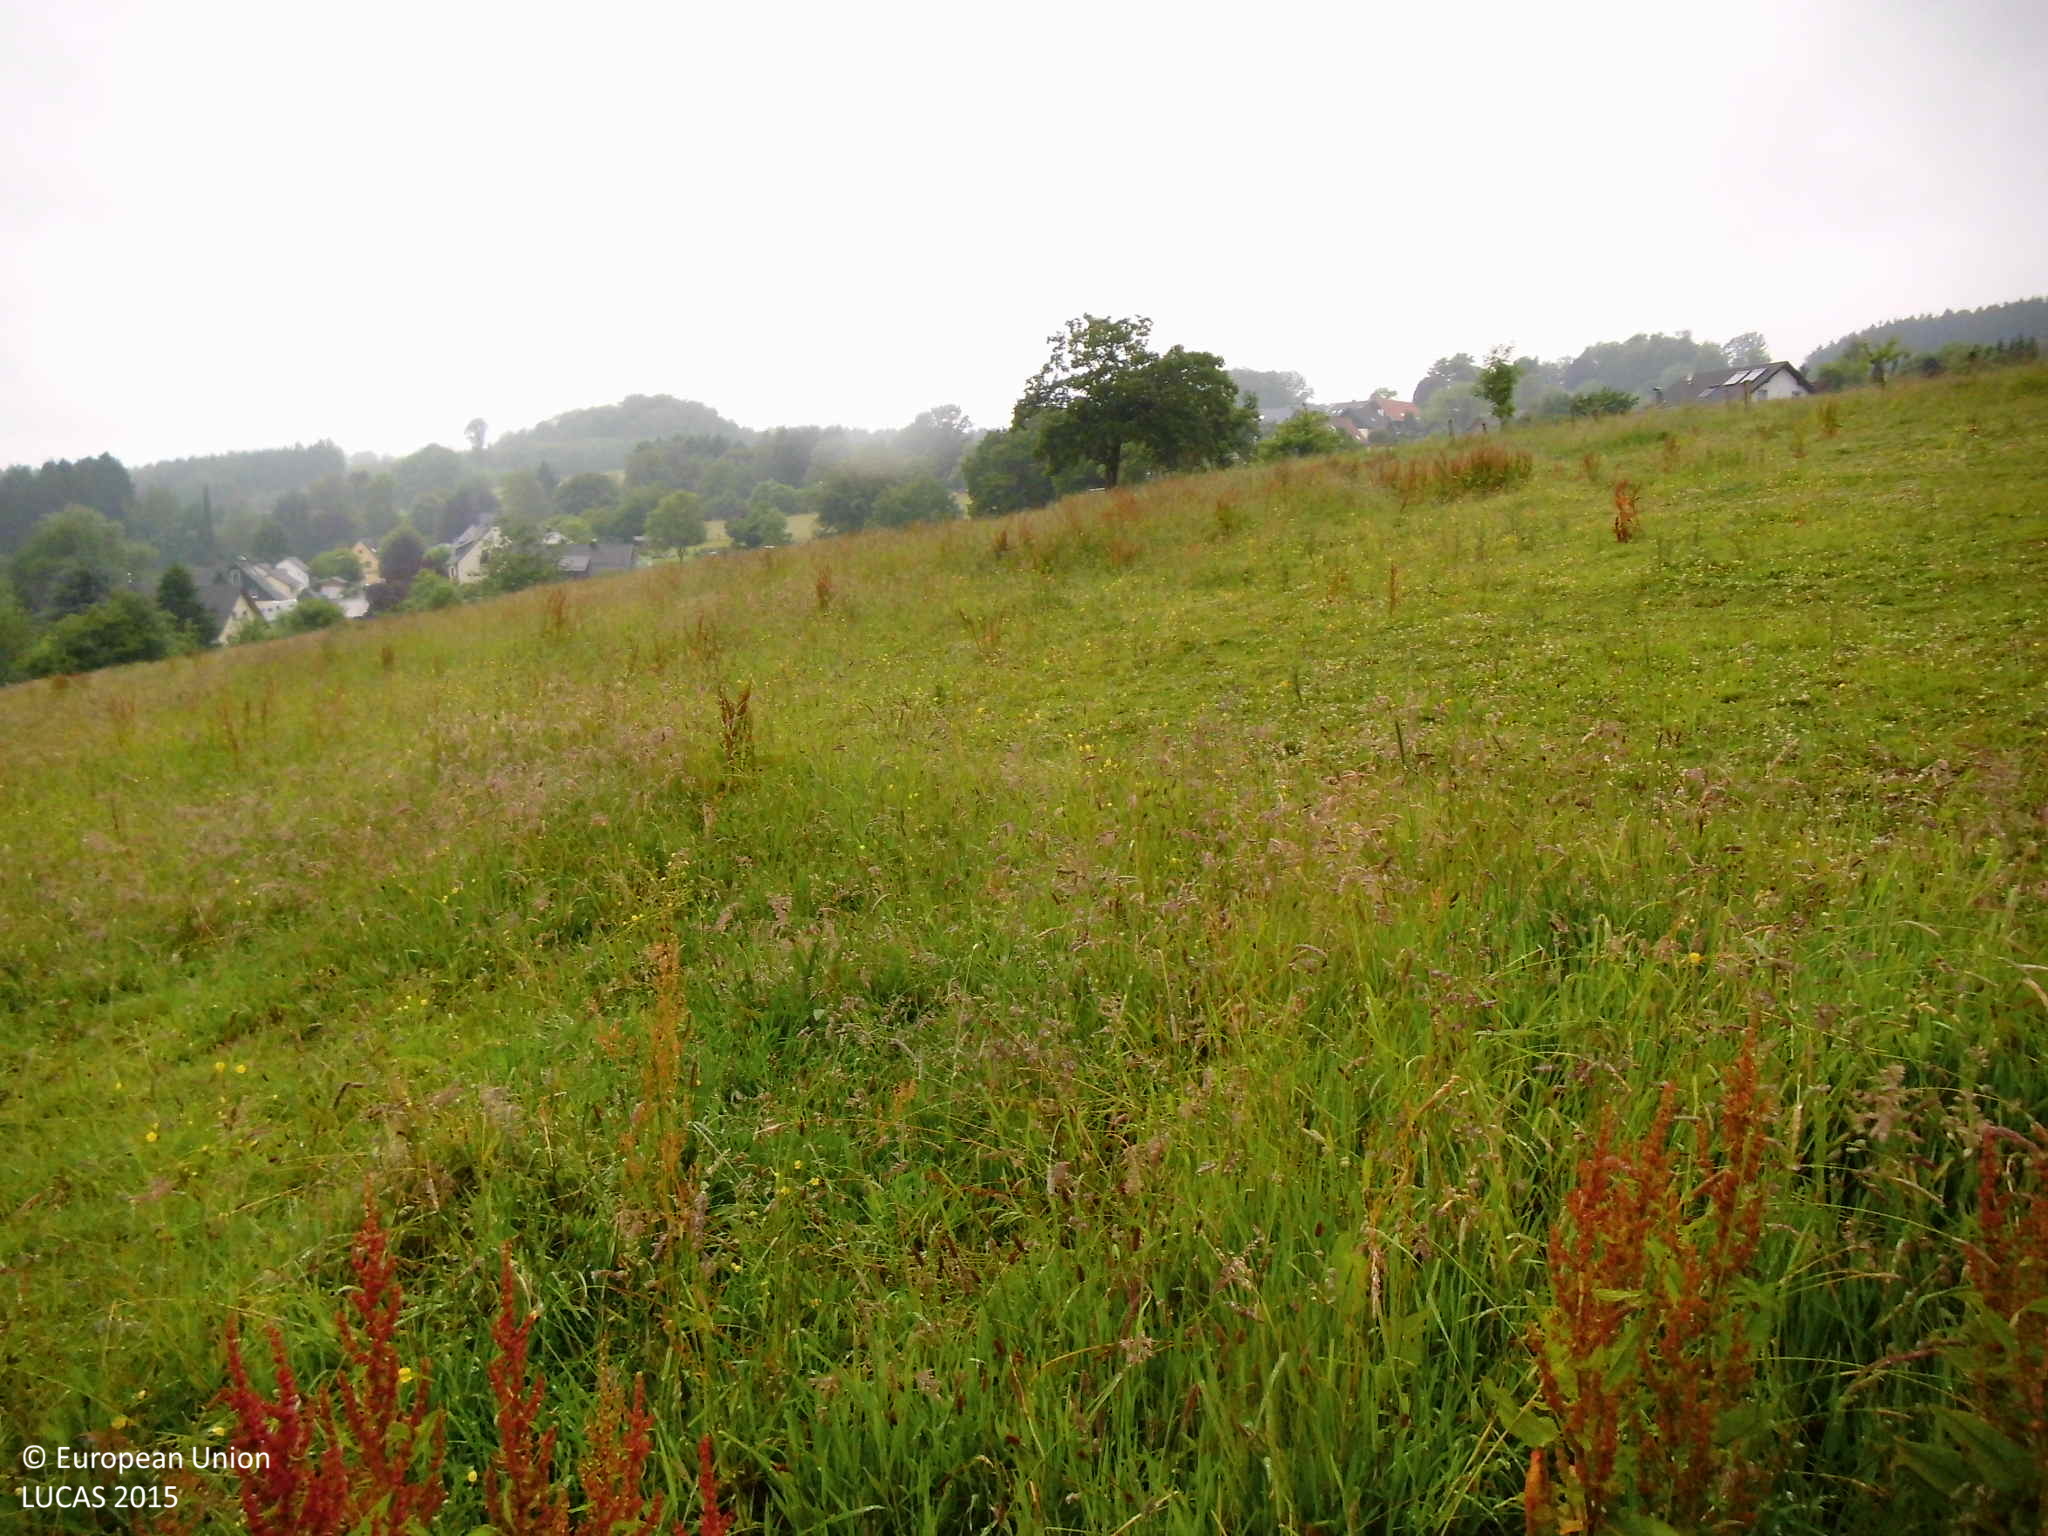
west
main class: Grassland
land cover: Grassland without tree/shrub cover
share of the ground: > 75 %
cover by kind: herbaceous plants 95 %, shrubs 5 %
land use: Agriculture (excluding fallow land and kitchen gardens)
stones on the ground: 10 - 25 %
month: June
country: DE
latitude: 51.0564
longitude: 7.5035
